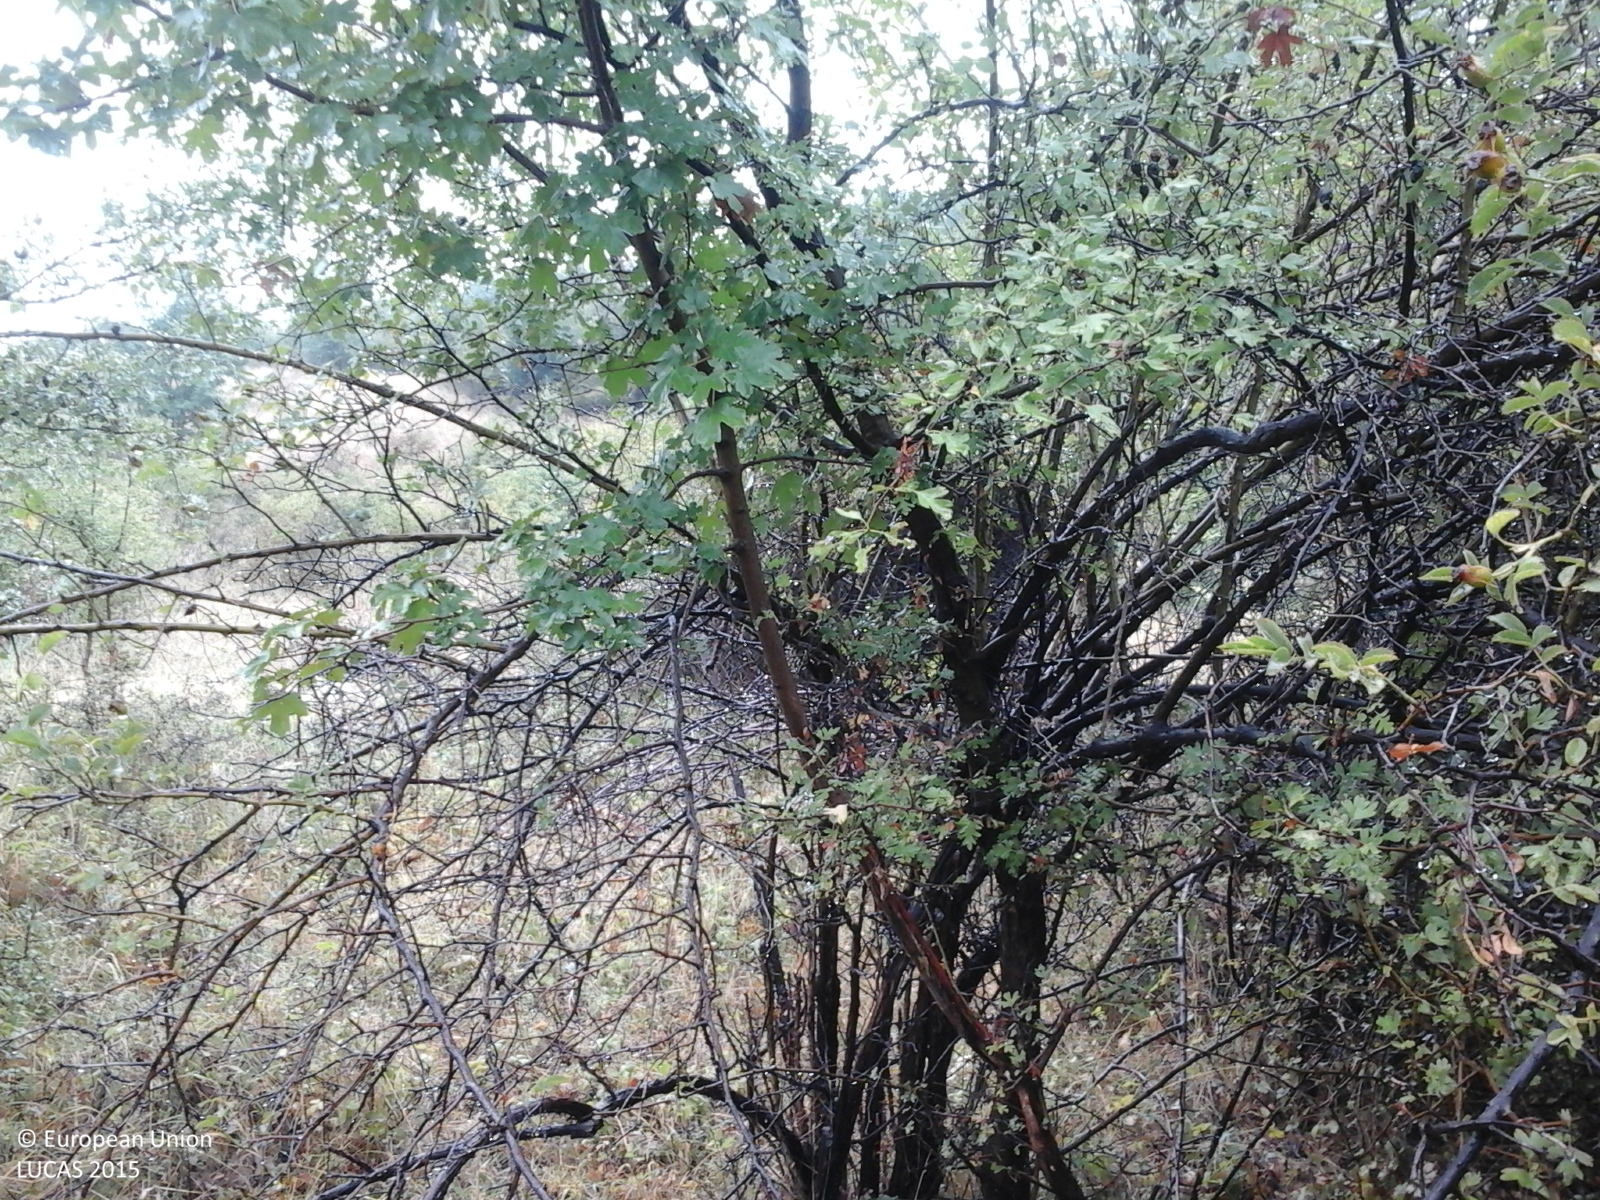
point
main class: Shrubland
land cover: Shrubland without tree cover
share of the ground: > 75 %
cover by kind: shrubs 100 %
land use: Semi-natural and natural areas not in use
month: August
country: RO
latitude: 44.5695
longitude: 22.8498
